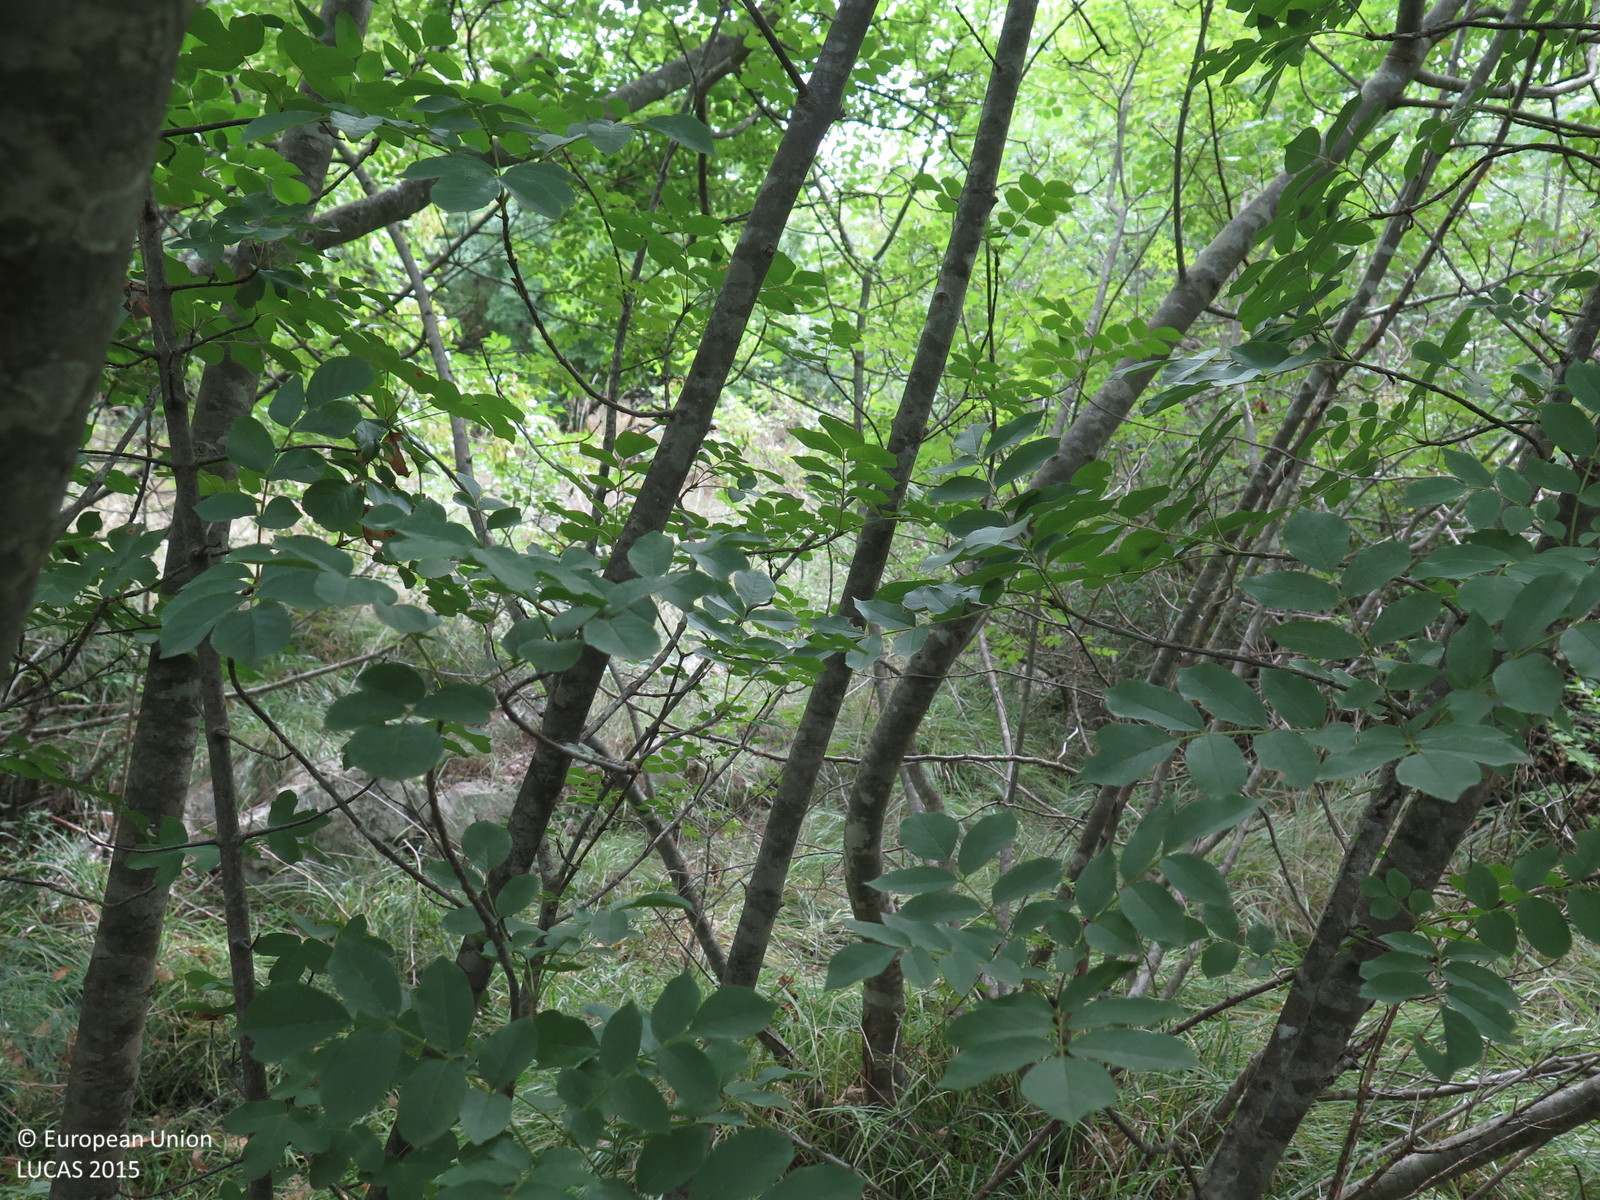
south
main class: Woodland
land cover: Broadleaved woodland
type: thermophilous deciduous forest
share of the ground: > 75 %
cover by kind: broadleaved forest trees 90 %, shrubs 5 %, herbaceous plants 5 %
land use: Semi-natural and natural areas not in use
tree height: > 5 m
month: August
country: HR
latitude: 45.1543
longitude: 14.5356
